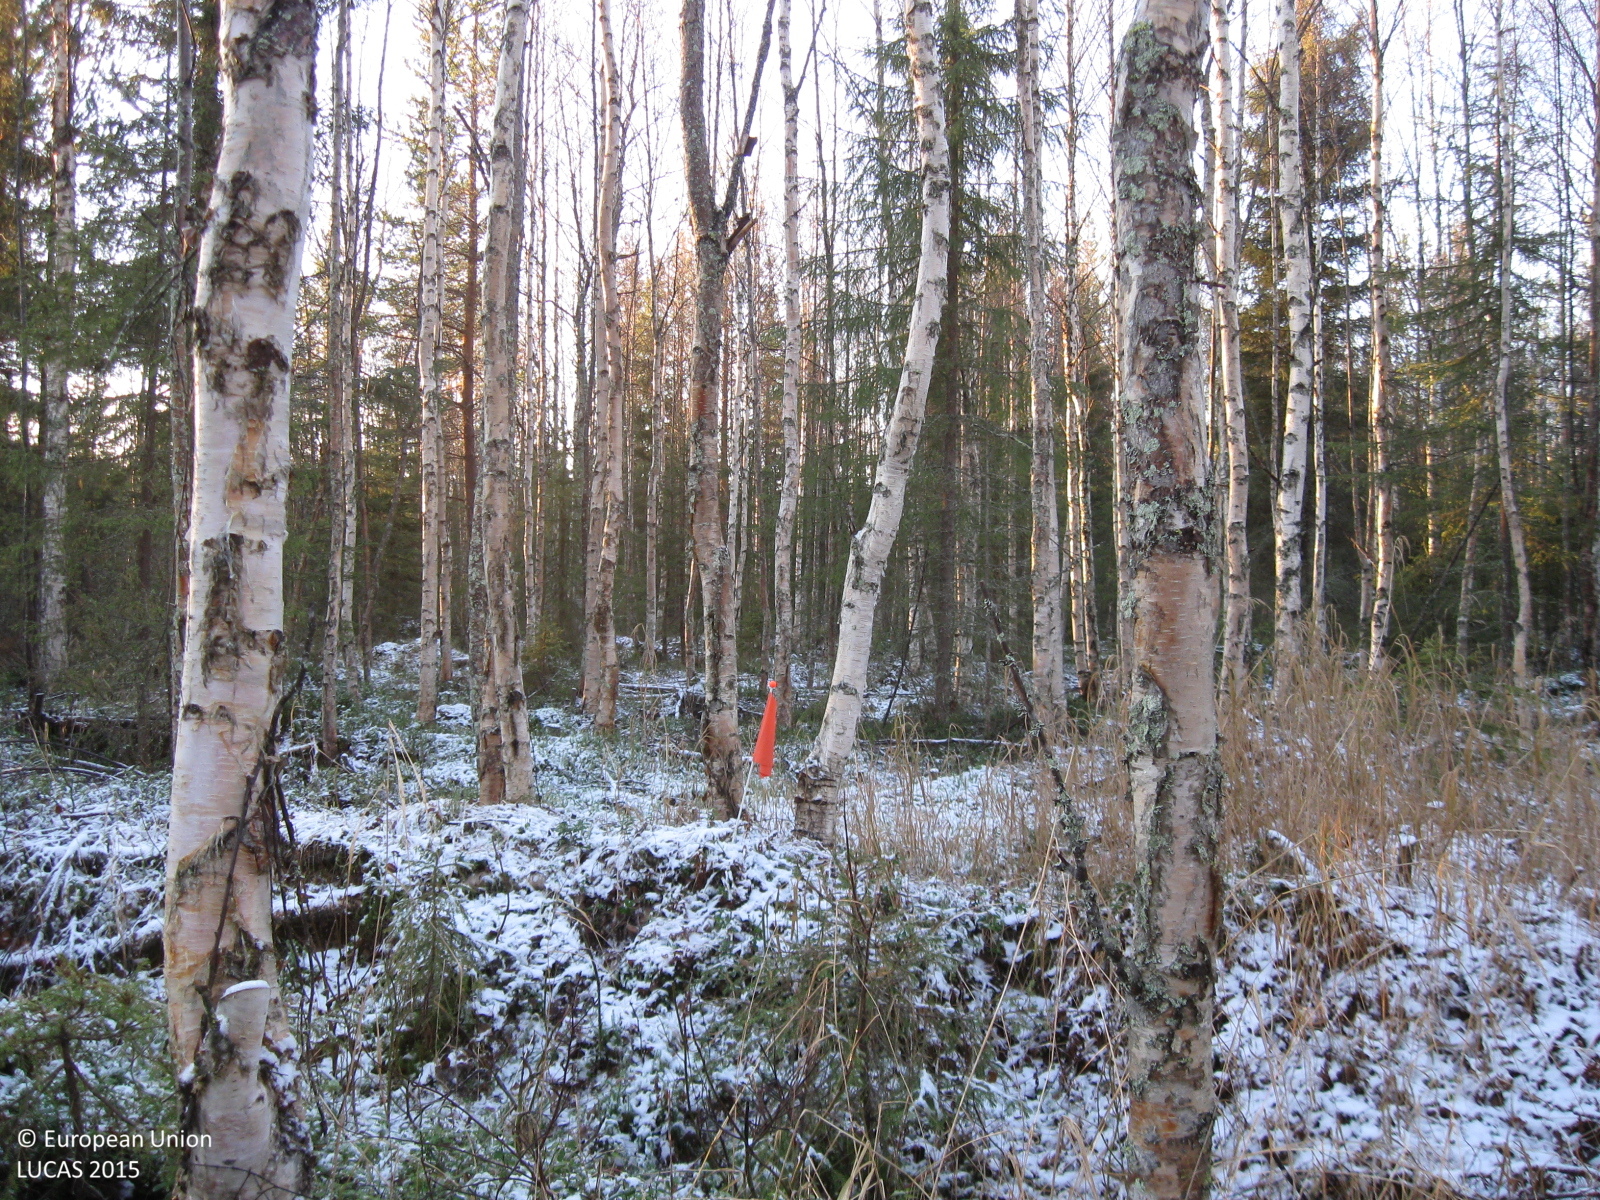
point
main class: Woodland
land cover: Spruce dominated mixed woodland
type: mire and swamp forests
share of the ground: > 75 %
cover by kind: broadleaved forest trees 55 %, coniferous forest trees 20 %, herbaceous plants 15 %, shrubs 10 %
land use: Forestry
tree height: > 5 m
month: October
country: SE
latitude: 66.3094
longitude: 20.8669
